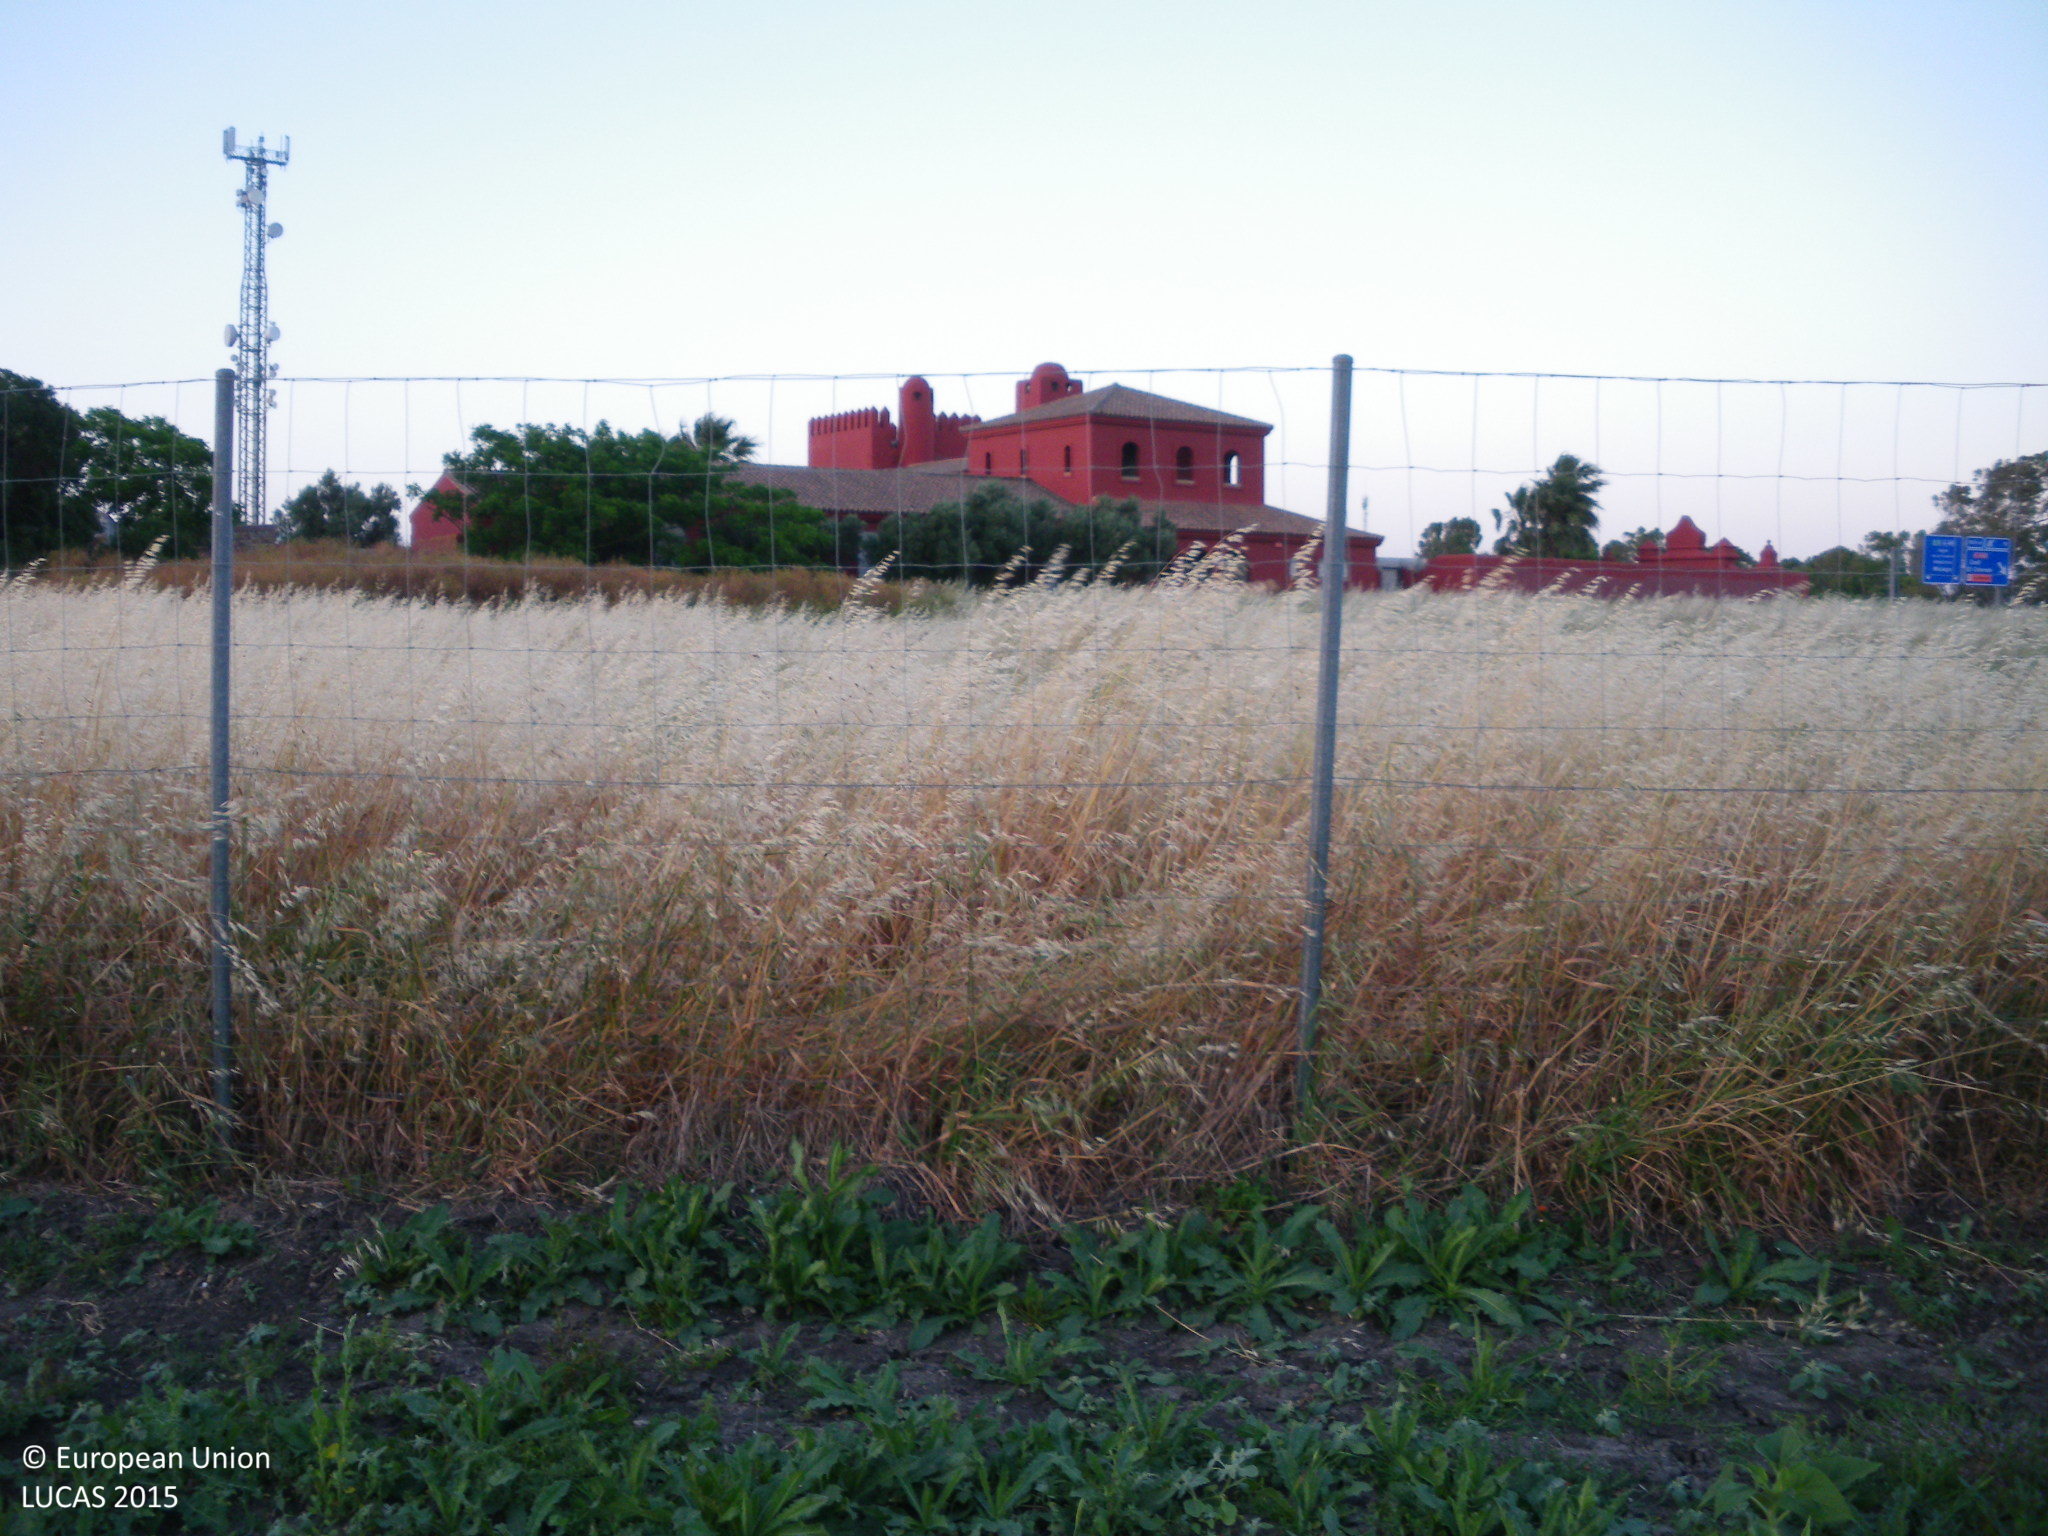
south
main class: Cropland
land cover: Sunflower
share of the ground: 25 - 50 %
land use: Agriculture (excluding fallow land and kitchen gardens)
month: May
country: ES
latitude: 36.3642
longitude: -6.1097
